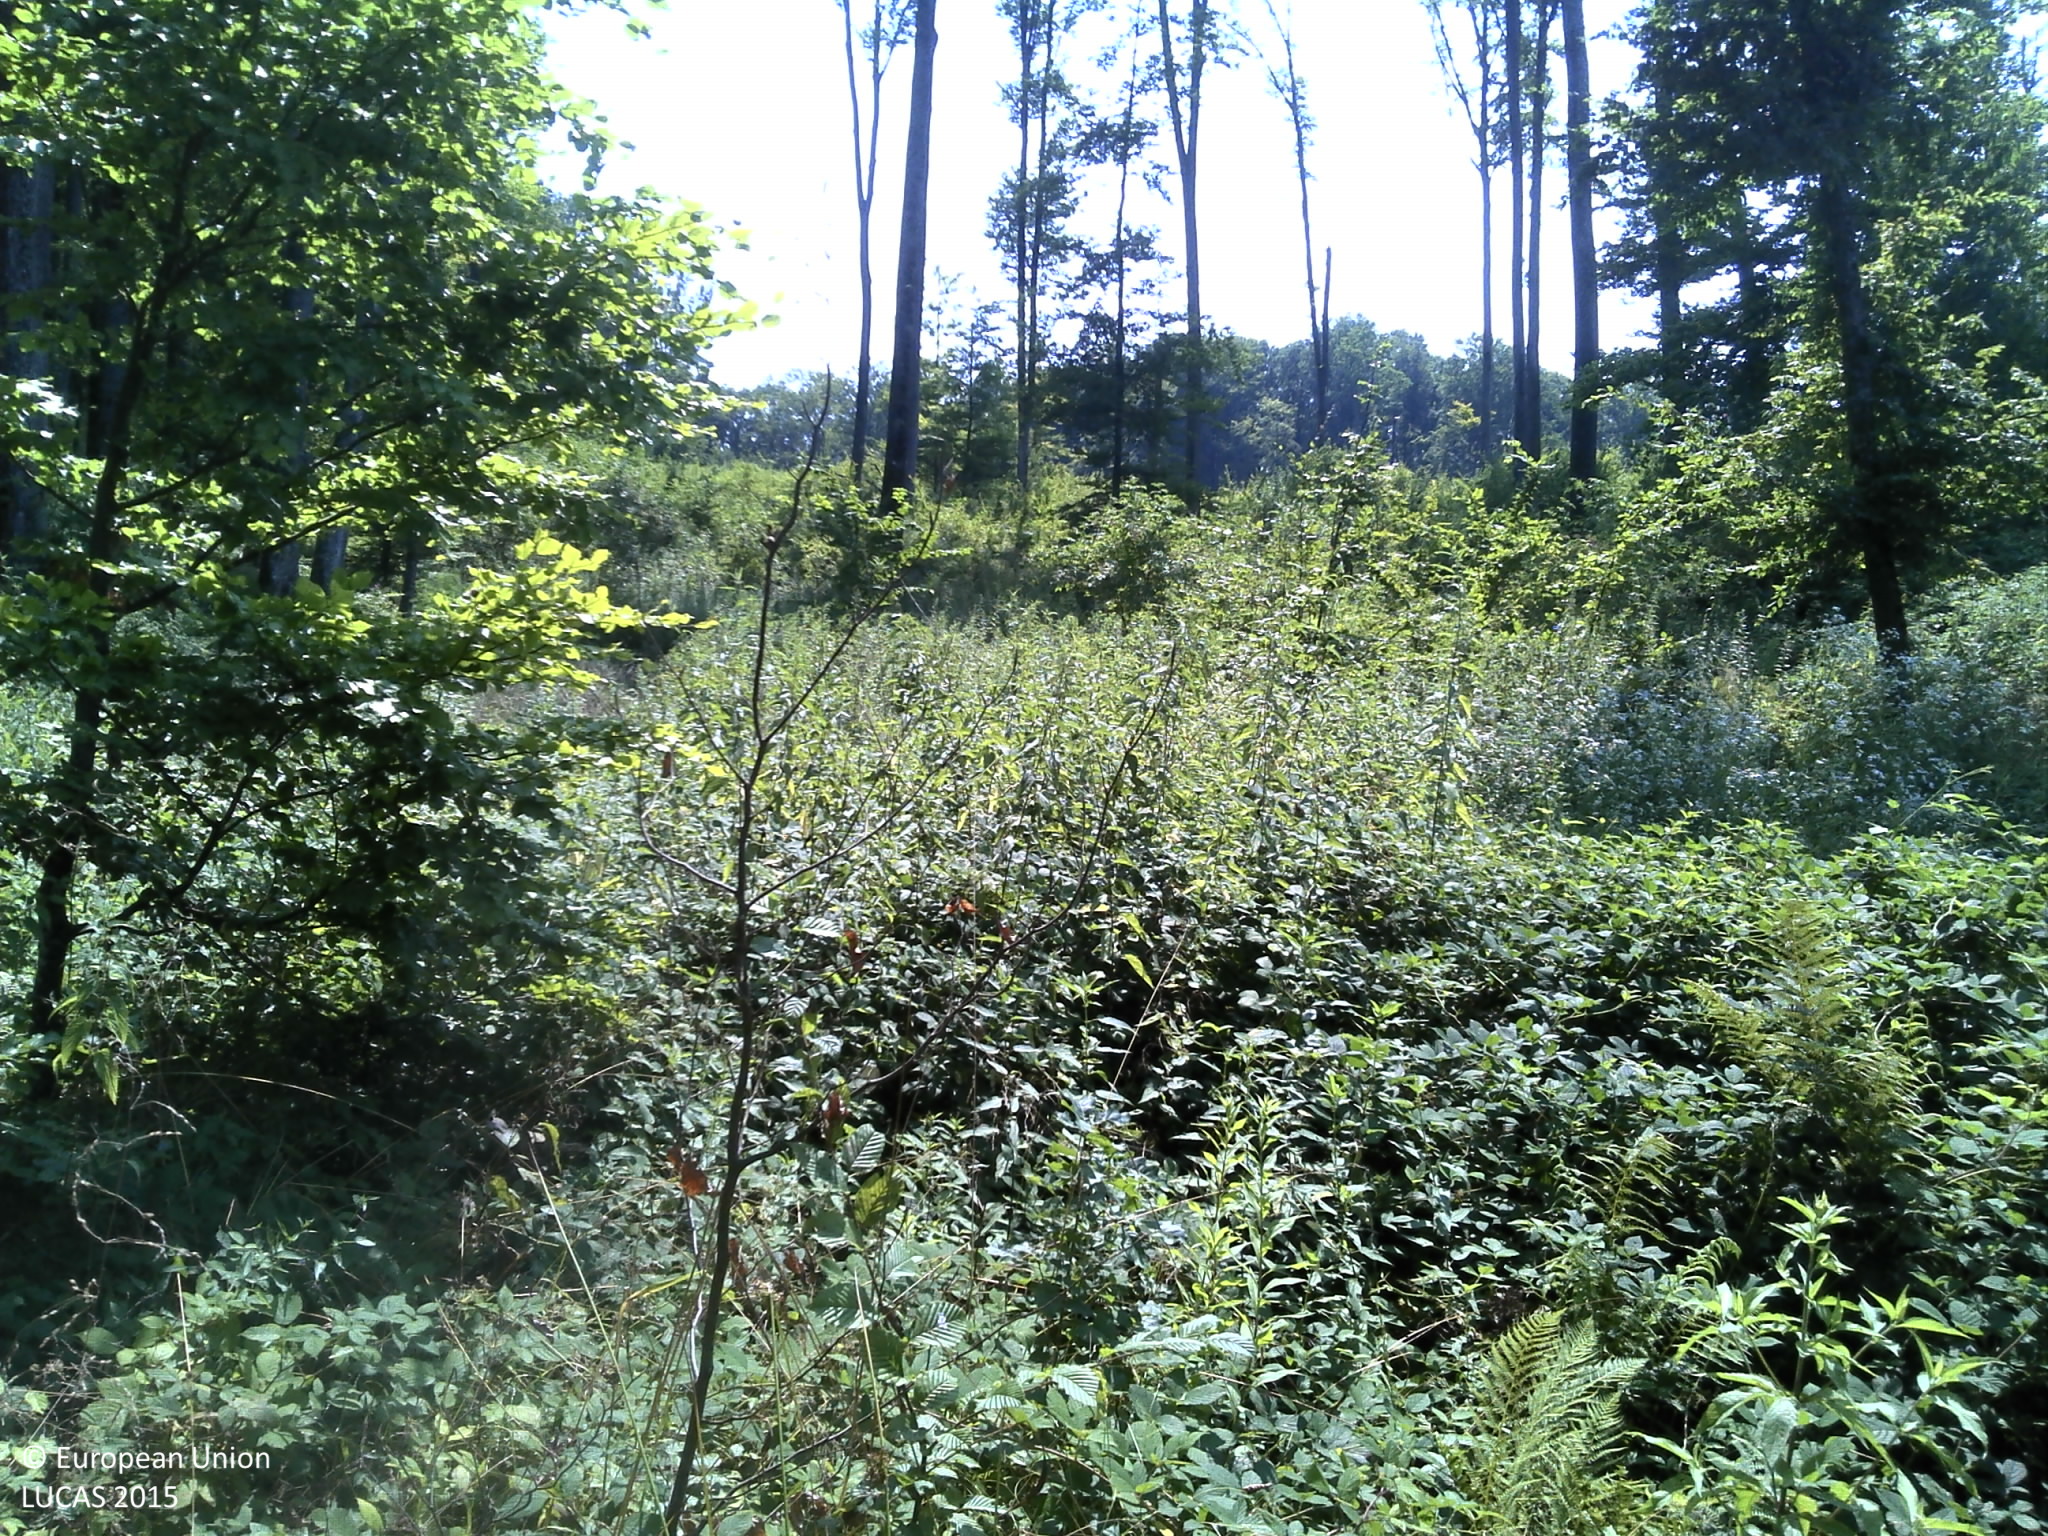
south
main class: Woodland
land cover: Broadleaved woodland
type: beech forest
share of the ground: > 75 %
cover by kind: broadleaved forest trees 100 %
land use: Forestry
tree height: > 5 m
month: July
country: HR
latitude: 45.6581
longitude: 17.1748
